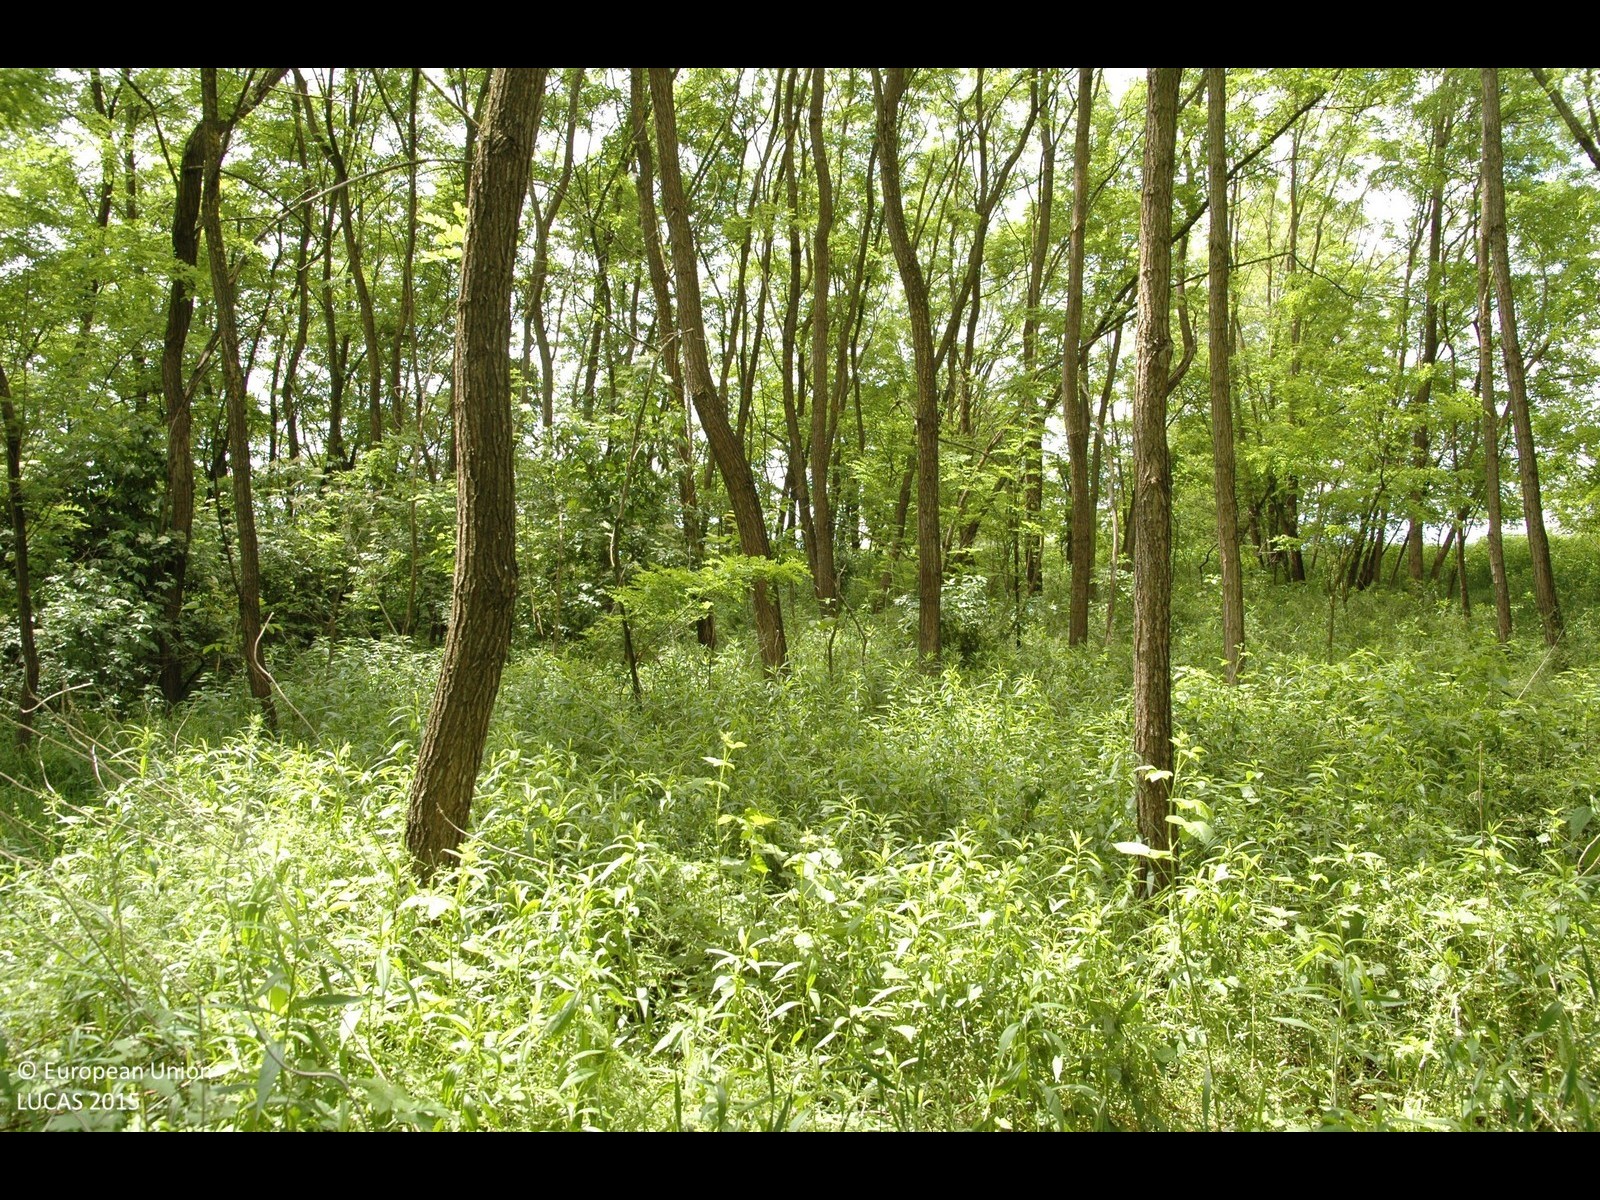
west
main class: Woodland
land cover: Broadleaved woodland
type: mesophytic deciduous forest
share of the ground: > 75 %
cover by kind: broadleaved forest trees 90 %, shrubs 5 %, herbaceous plants 5 %
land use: Forestry
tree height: > 5 m
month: May
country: HR
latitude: 46.4100
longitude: 16.4401
